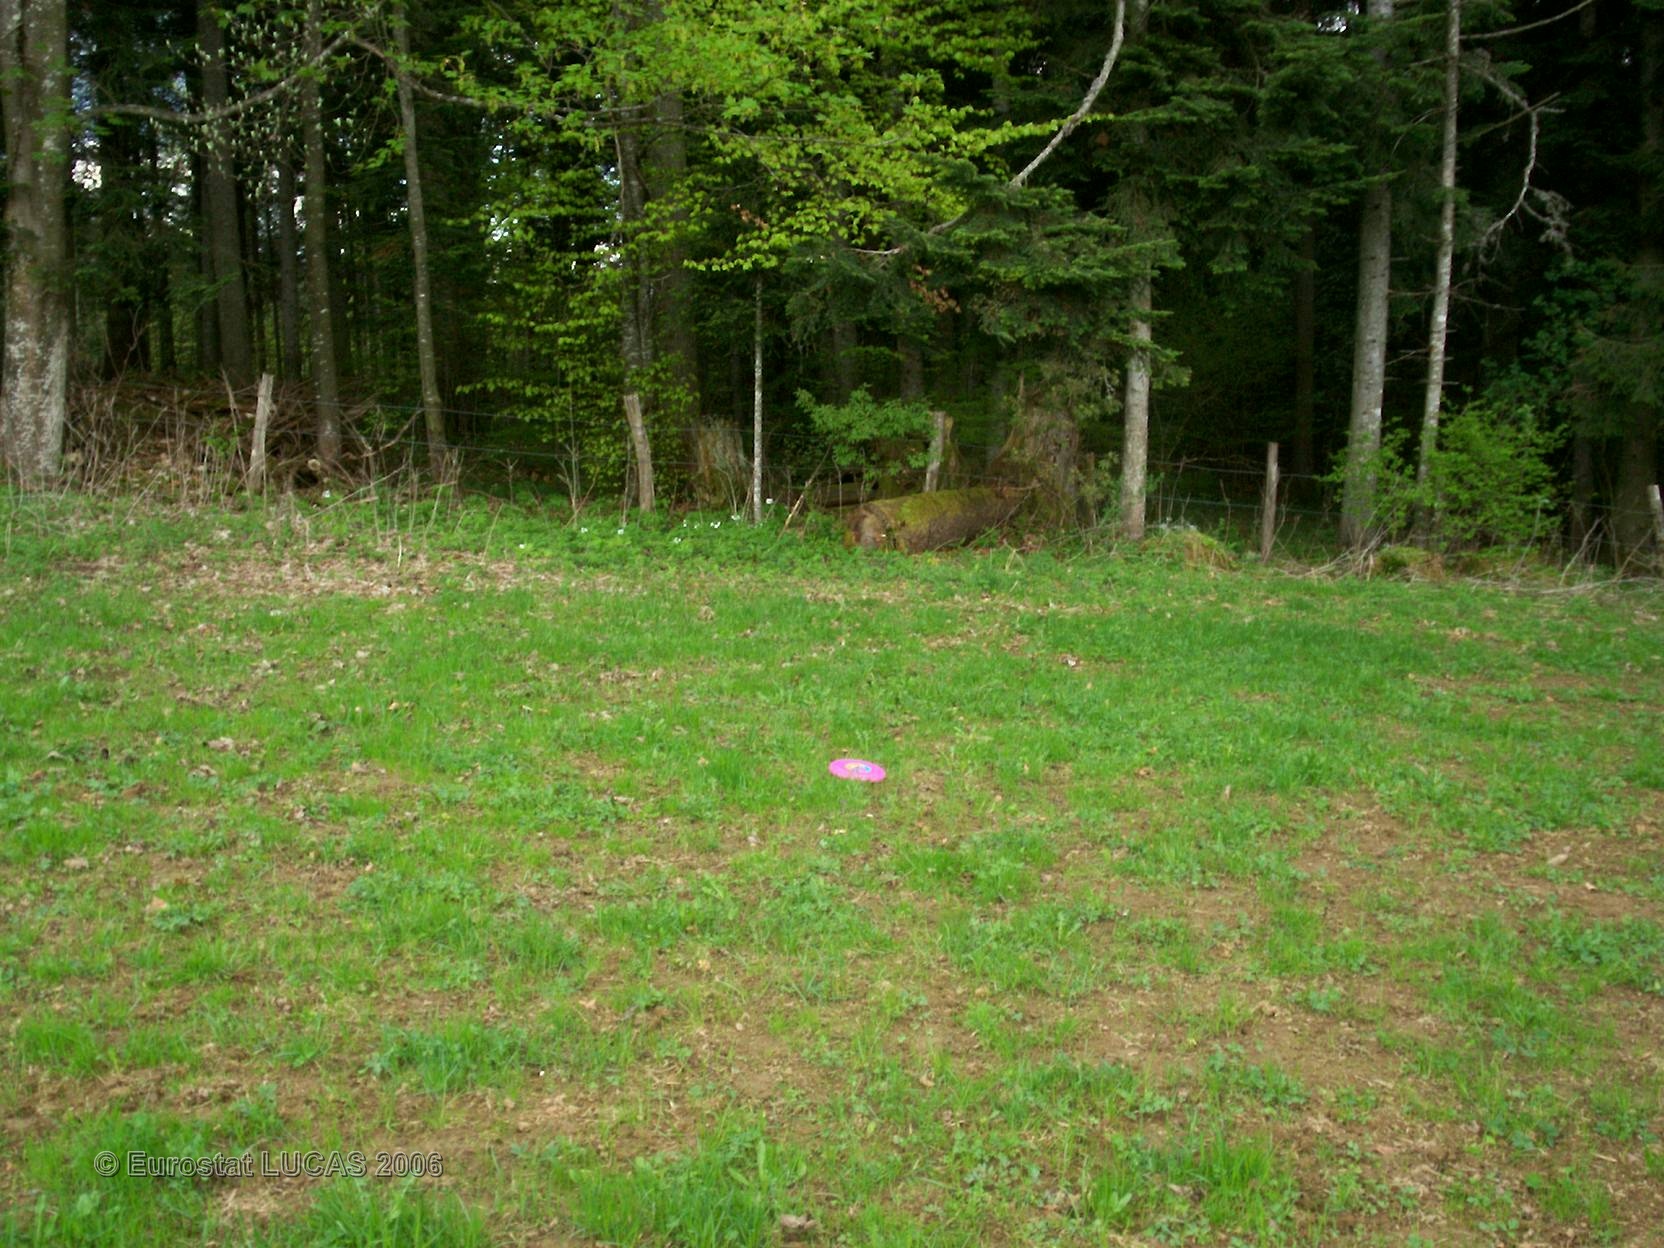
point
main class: Grassland
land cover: Grassland without tree/shrub cover
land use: Agriculture (excluding fallow land and kitchen gardens)
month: May
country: FR
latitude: 47.1455
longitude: 6.6395
